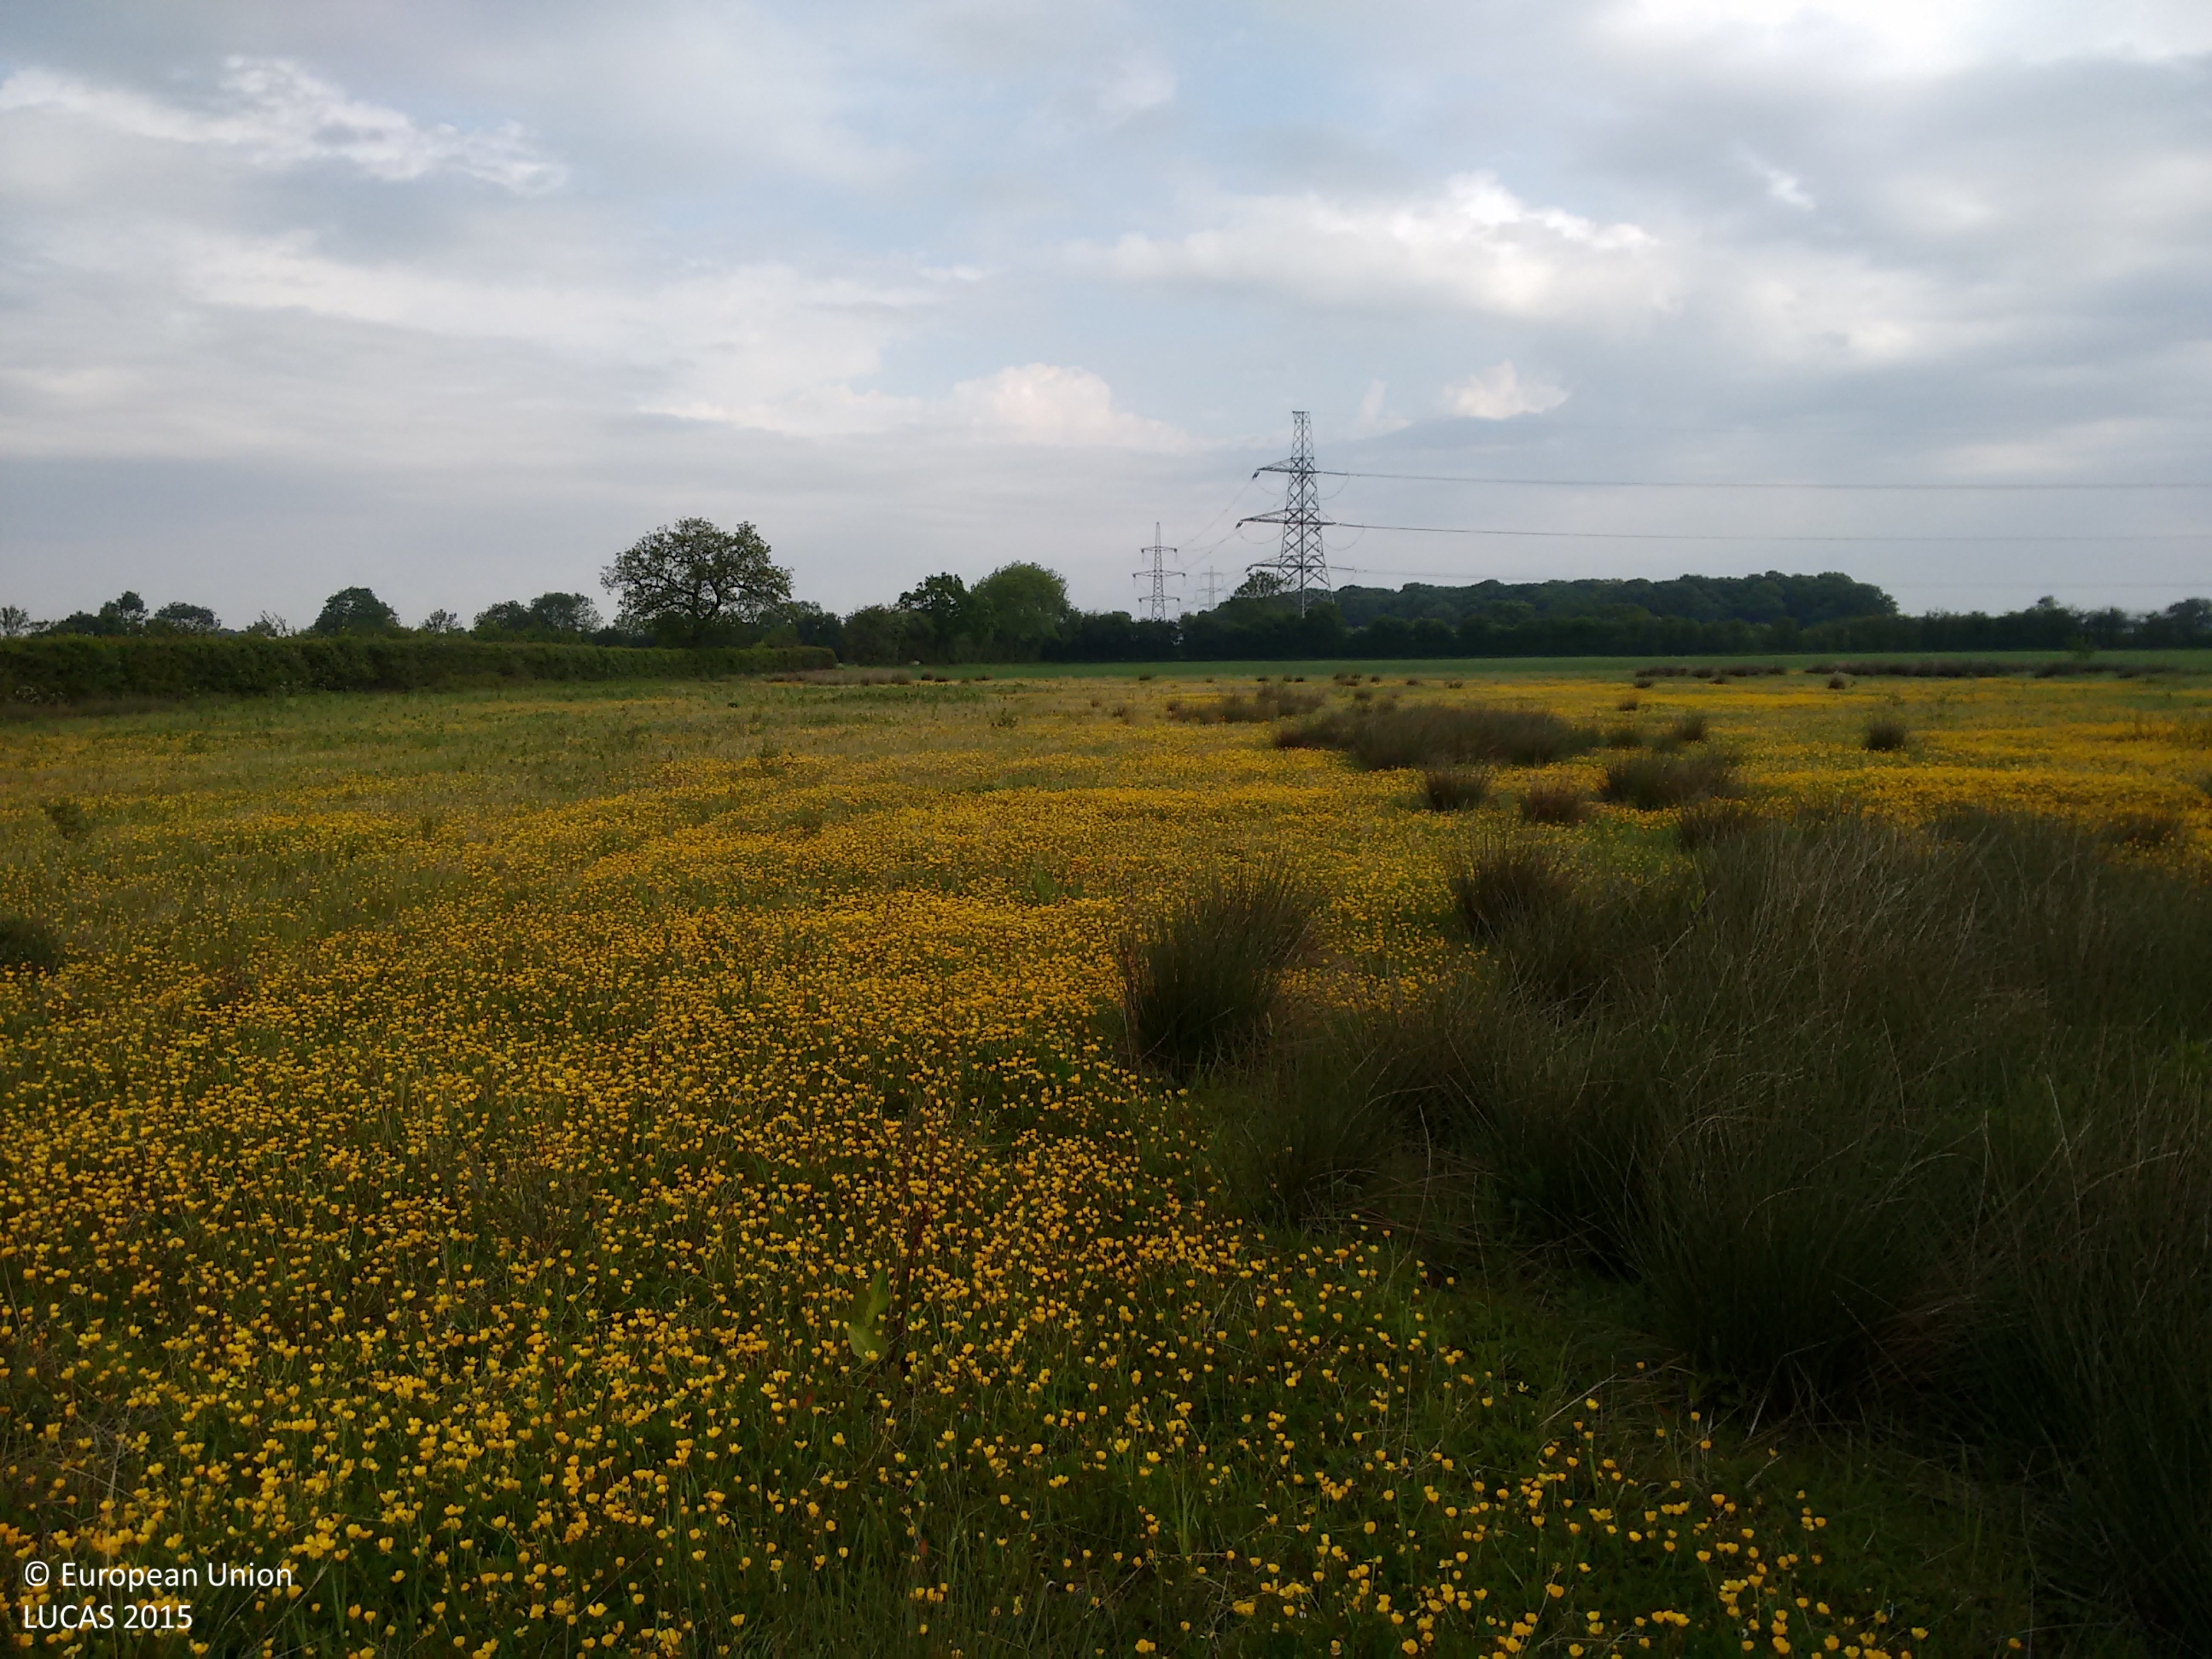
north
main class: Grassland
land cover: Spontaneously vegetated surfaces
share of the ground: > 75 %
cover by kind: herbaceous plants 95 %, shrubs 5 %
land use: Fallow land
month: June
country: GB
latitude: 54.0298
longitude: -1.1432
